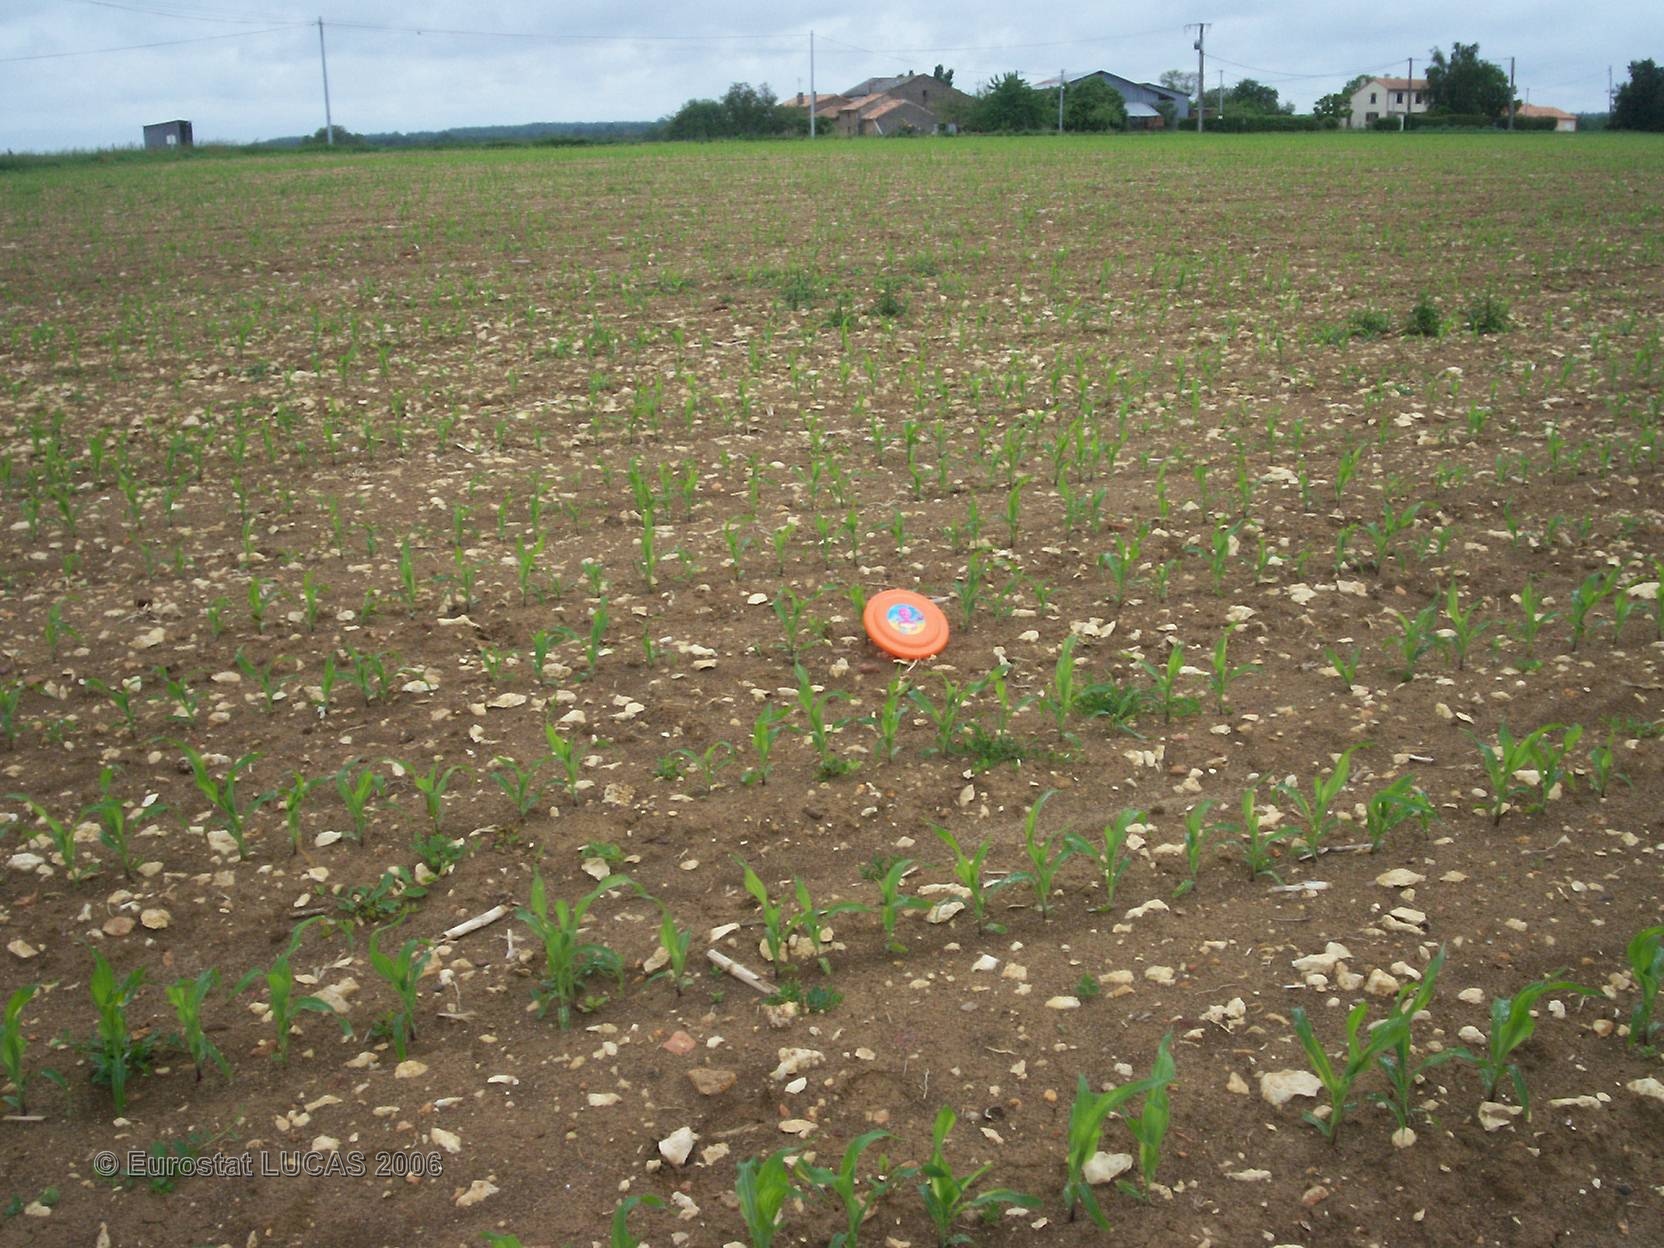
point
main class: Cropland
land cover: Maize
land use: Agriculture (excluding fallow land and kitchen gardens)
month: May
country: FR
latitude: 46.6666
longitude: 0.4533
